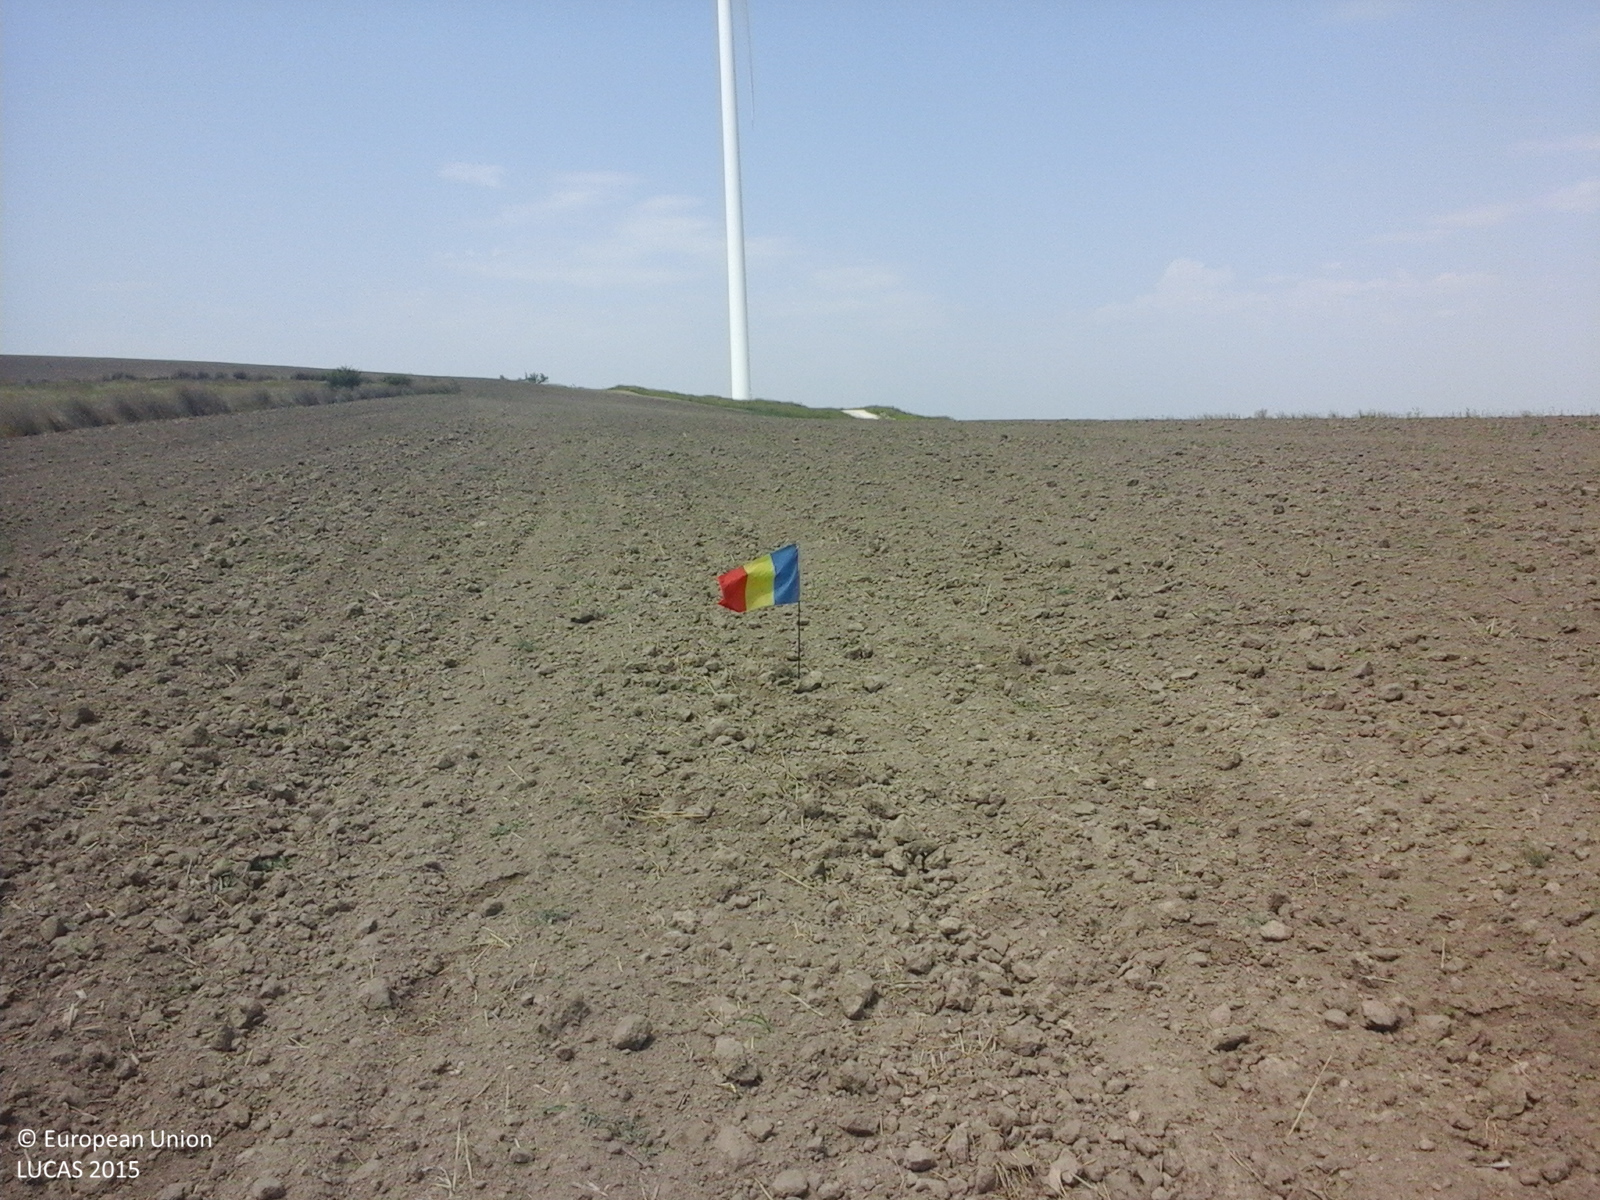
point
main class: Cropland
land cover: Common wheat
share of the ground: < 10 %
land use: Agriculture (excluding fallow land and kitchen gardens)
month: August
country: RO
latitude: 44.2149
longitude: 28.0155
